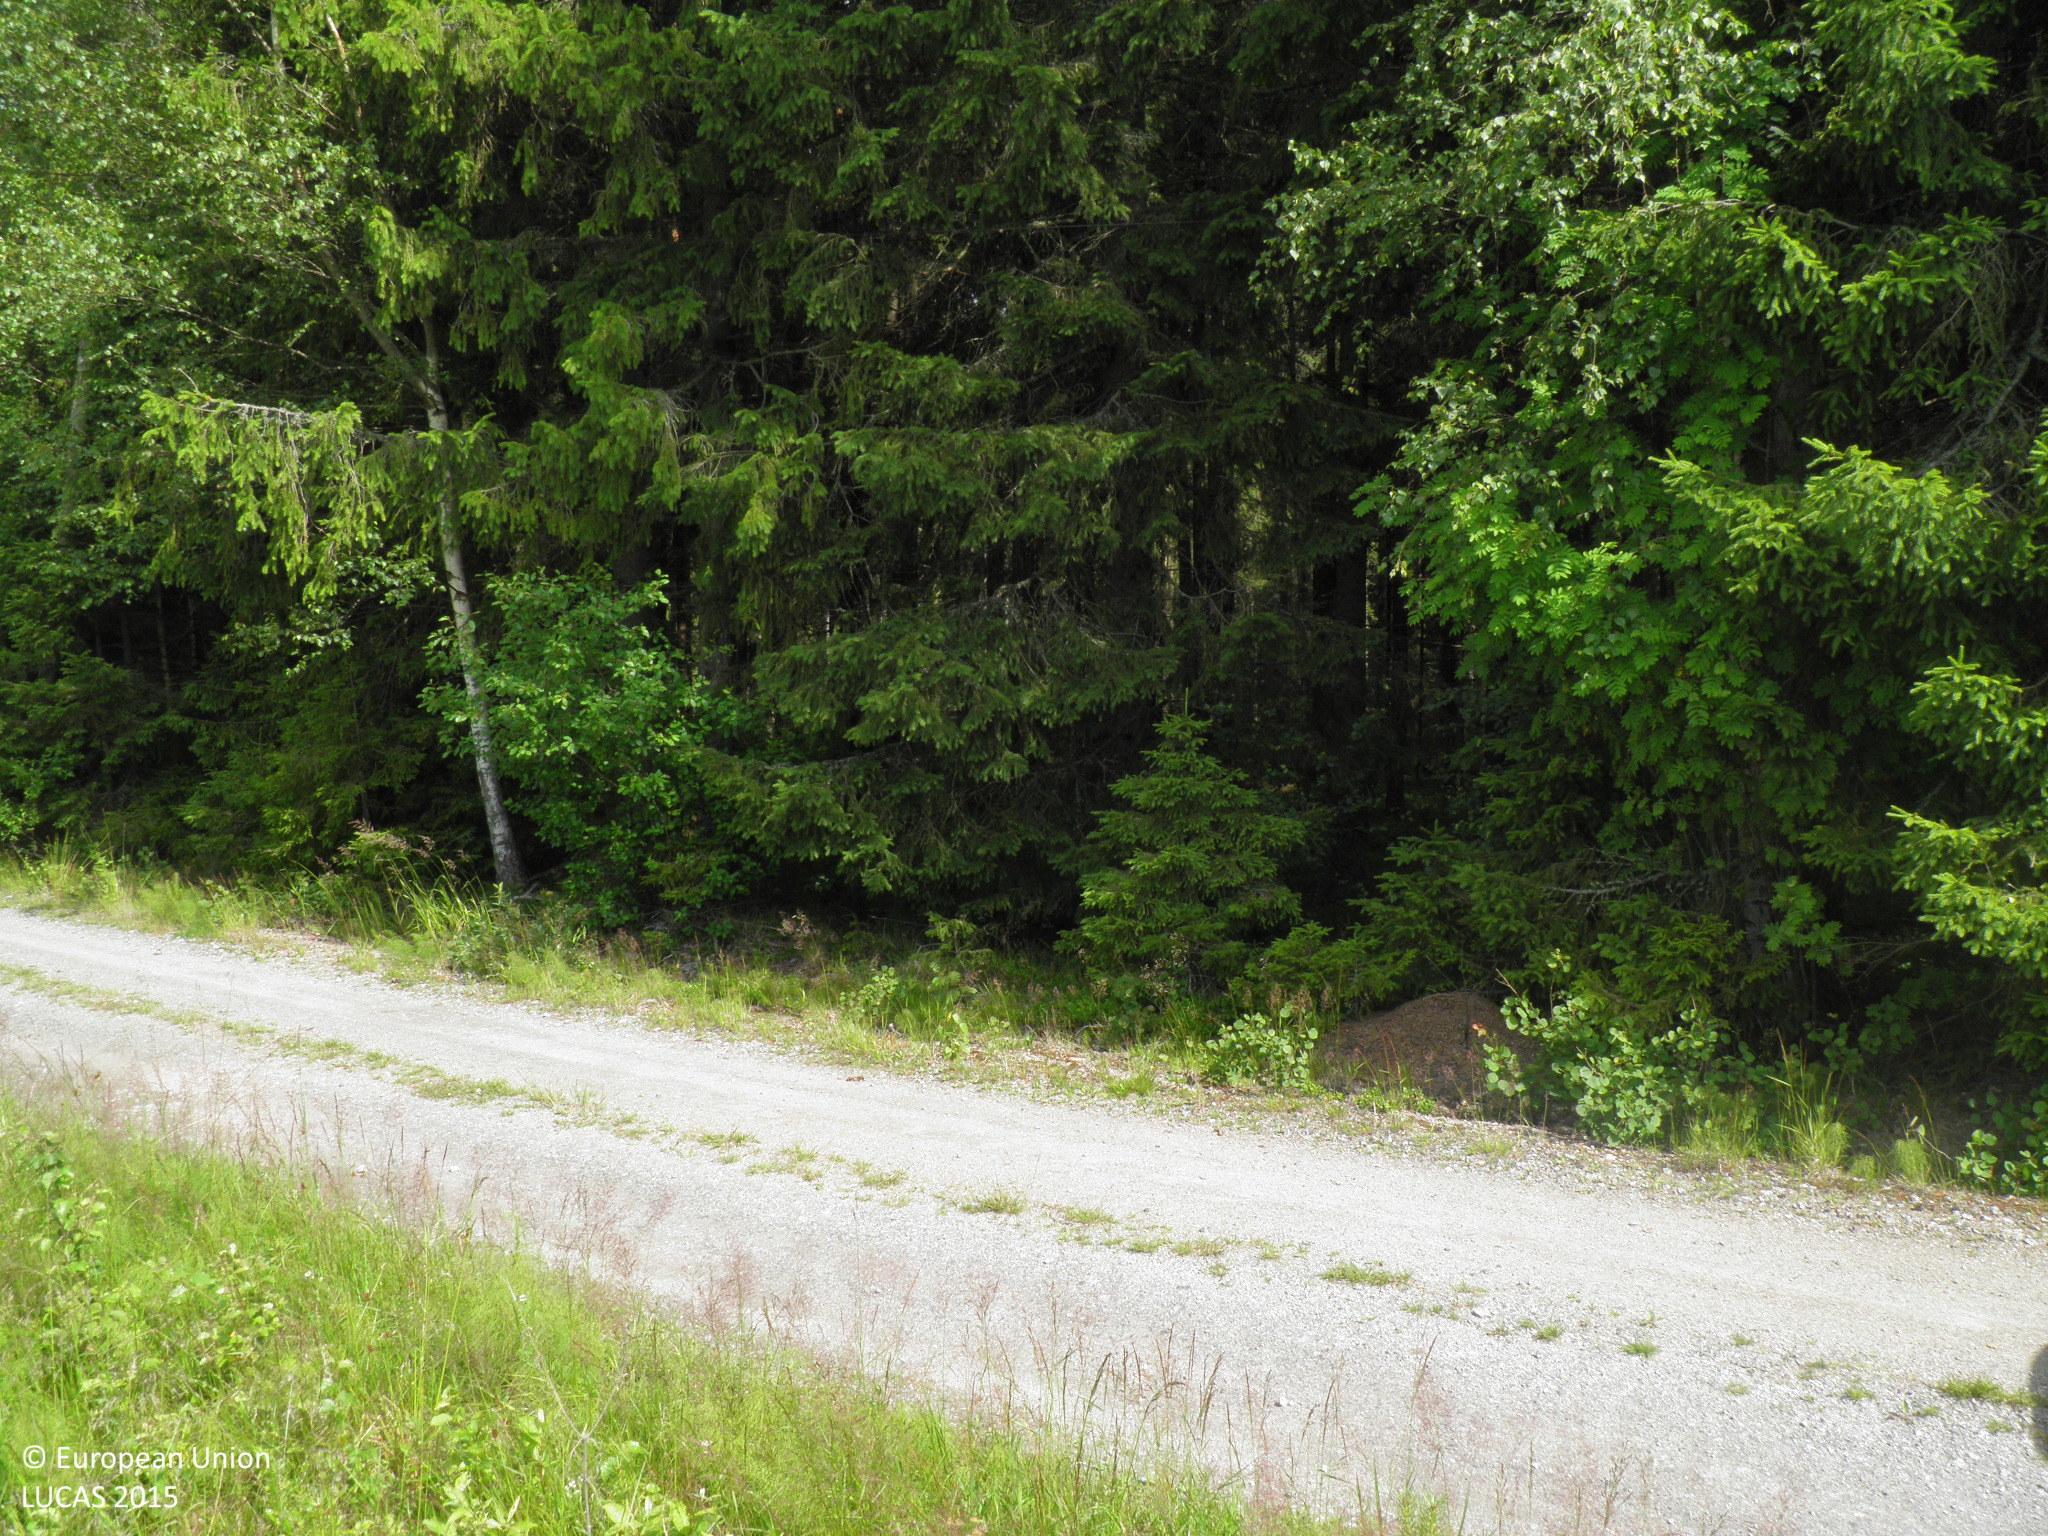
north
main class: Cropland
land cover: Barley
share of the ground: > 75 %
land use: Agriculture (excluding fallow land and kitchen gardens)
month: July
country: FI
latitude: 60.7292
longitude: 22.3696
